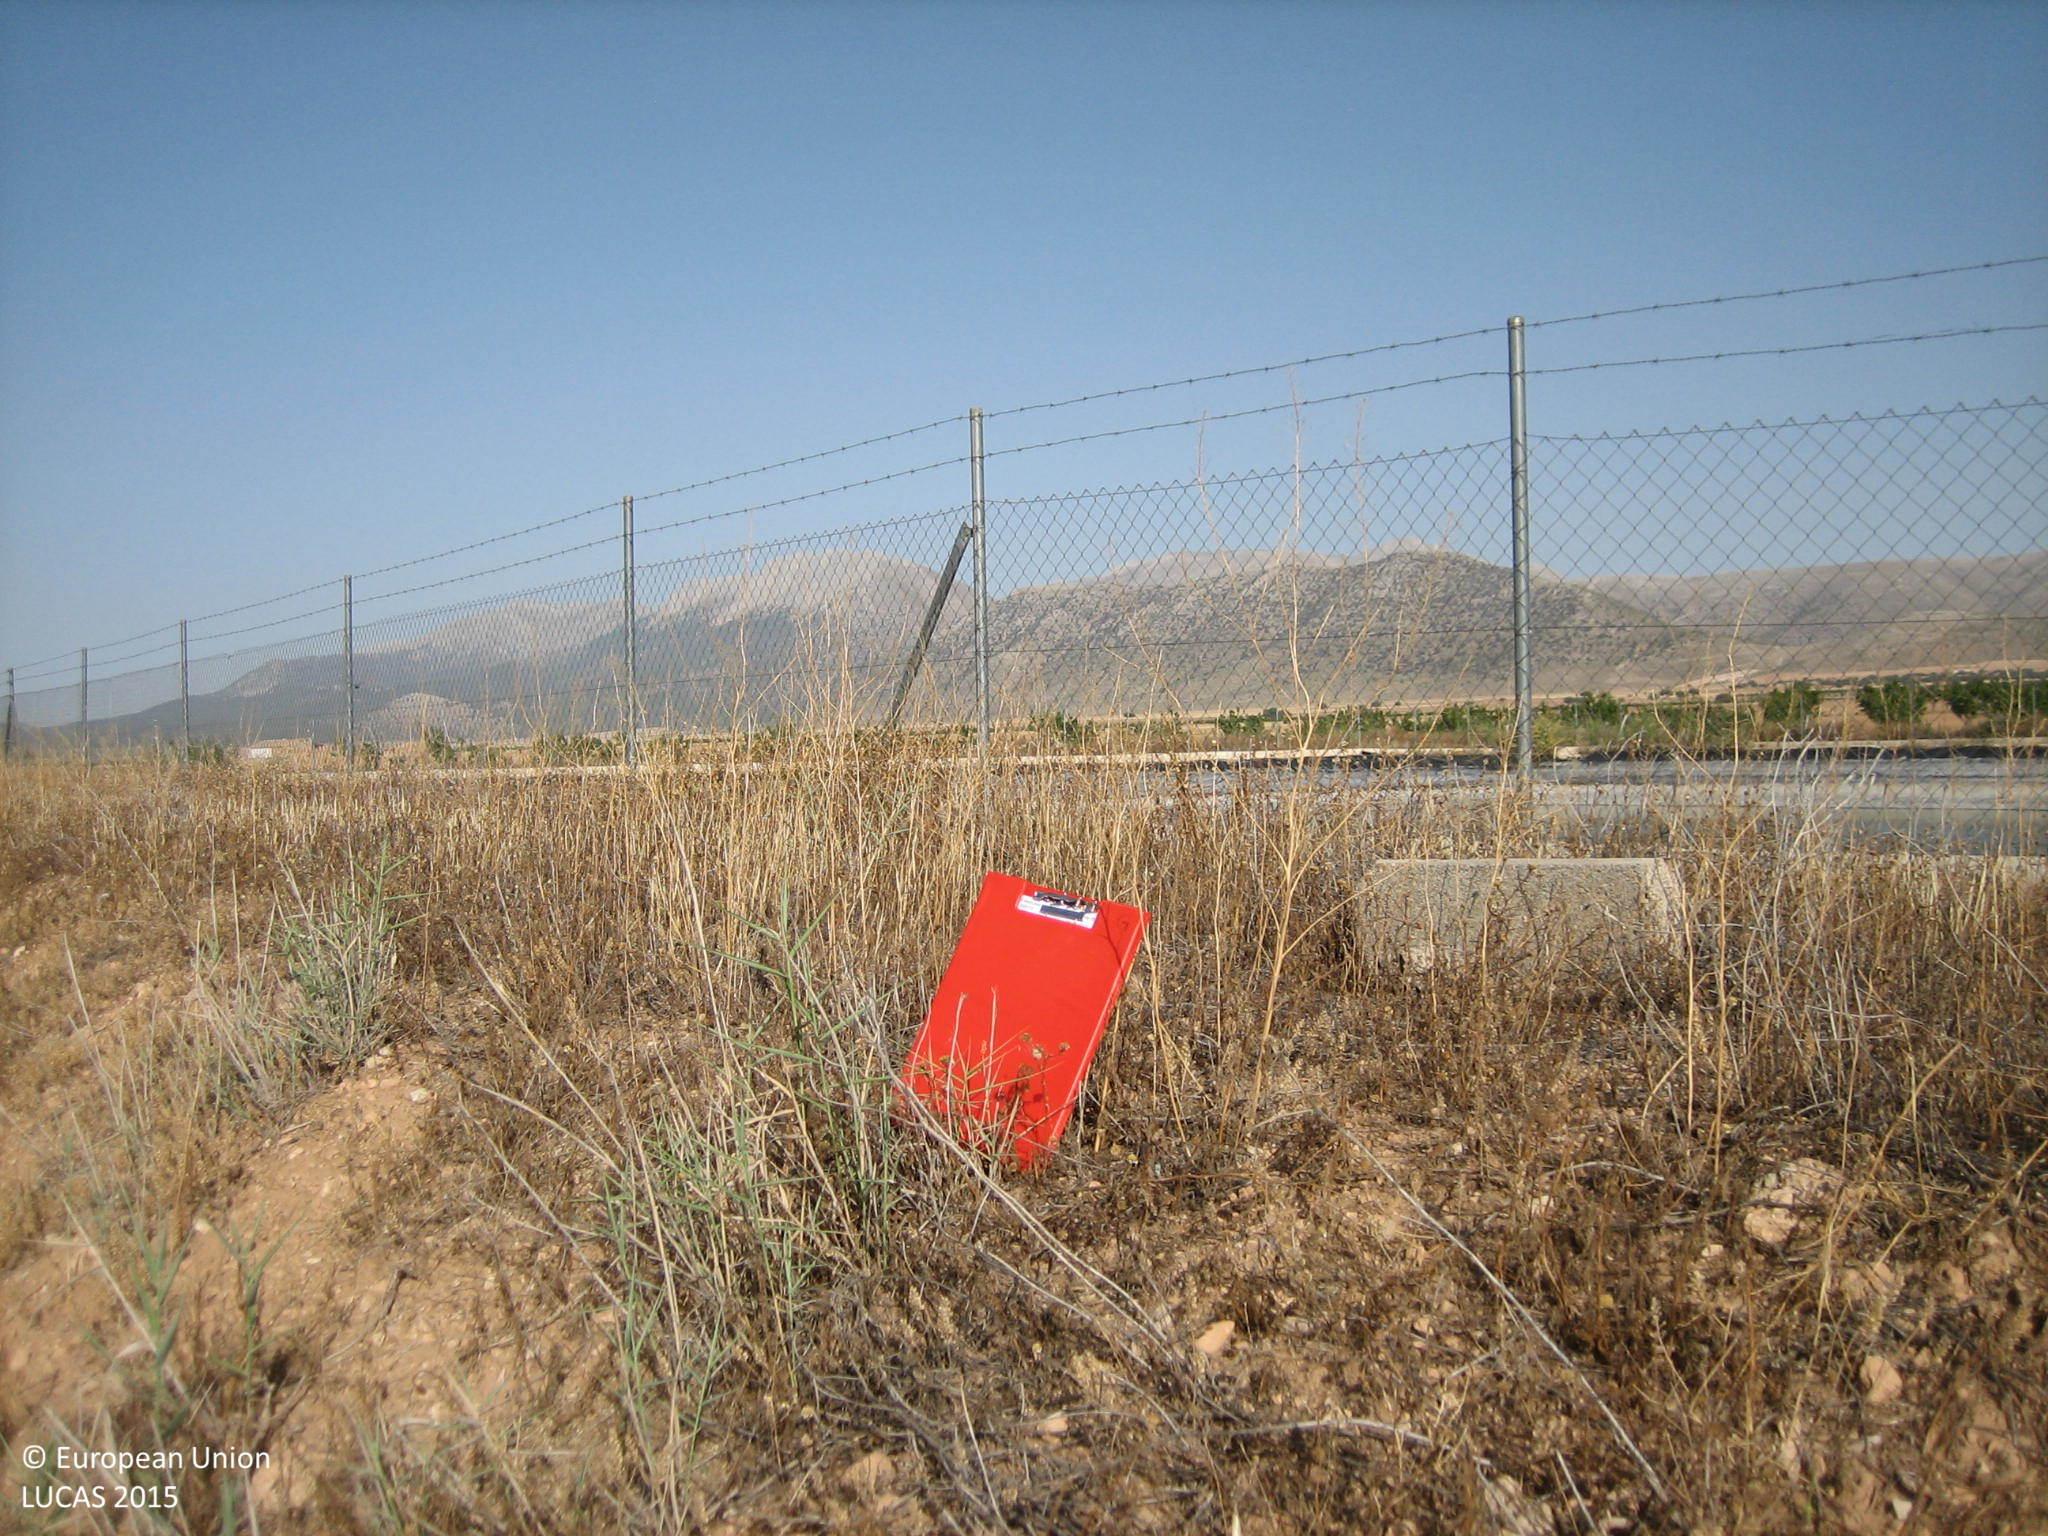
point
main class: Grassland
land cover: Grassland without tree/shrub cover
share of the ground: 50 - 75 %
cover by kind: herbaceous plants 60 %, unconsolidated bare surface 40 %
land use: Protection infrastructures
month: July
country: ES
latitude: 37.6892
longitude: -2.3591
